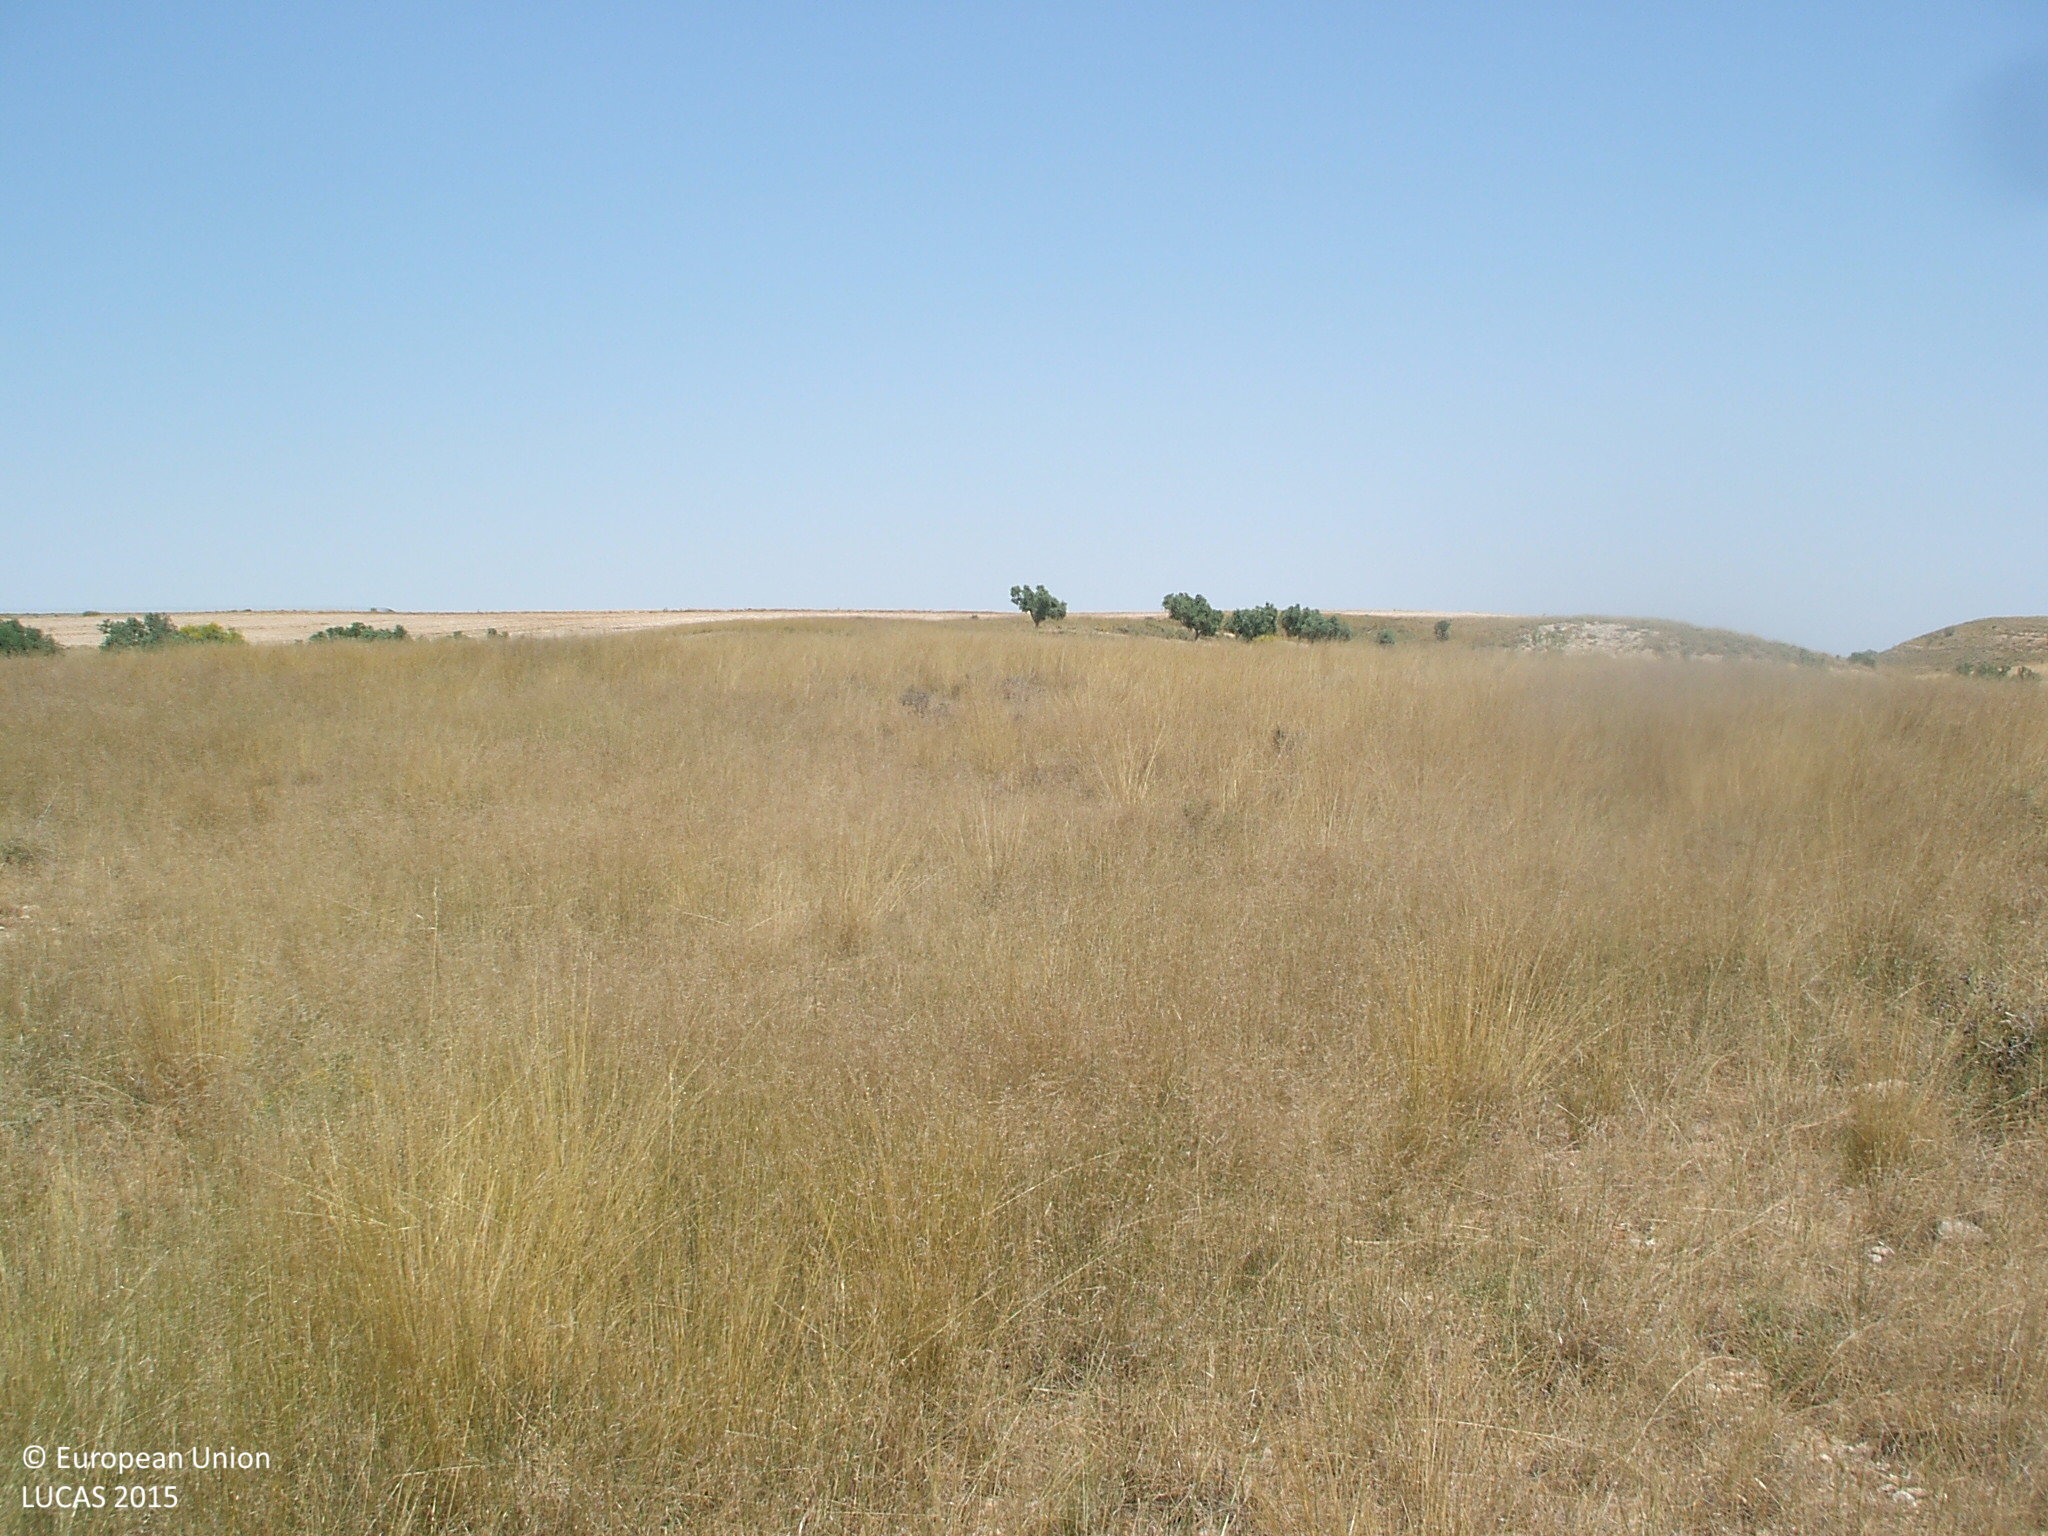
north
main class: Grassland
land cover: Grassland without tree/shrub cover
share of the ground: > 75 %
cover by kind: herbaceous plants 100 %
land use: Semi-natural and natural areas not in use
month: June
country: ES
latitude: 40.9915
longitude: -0.1983
